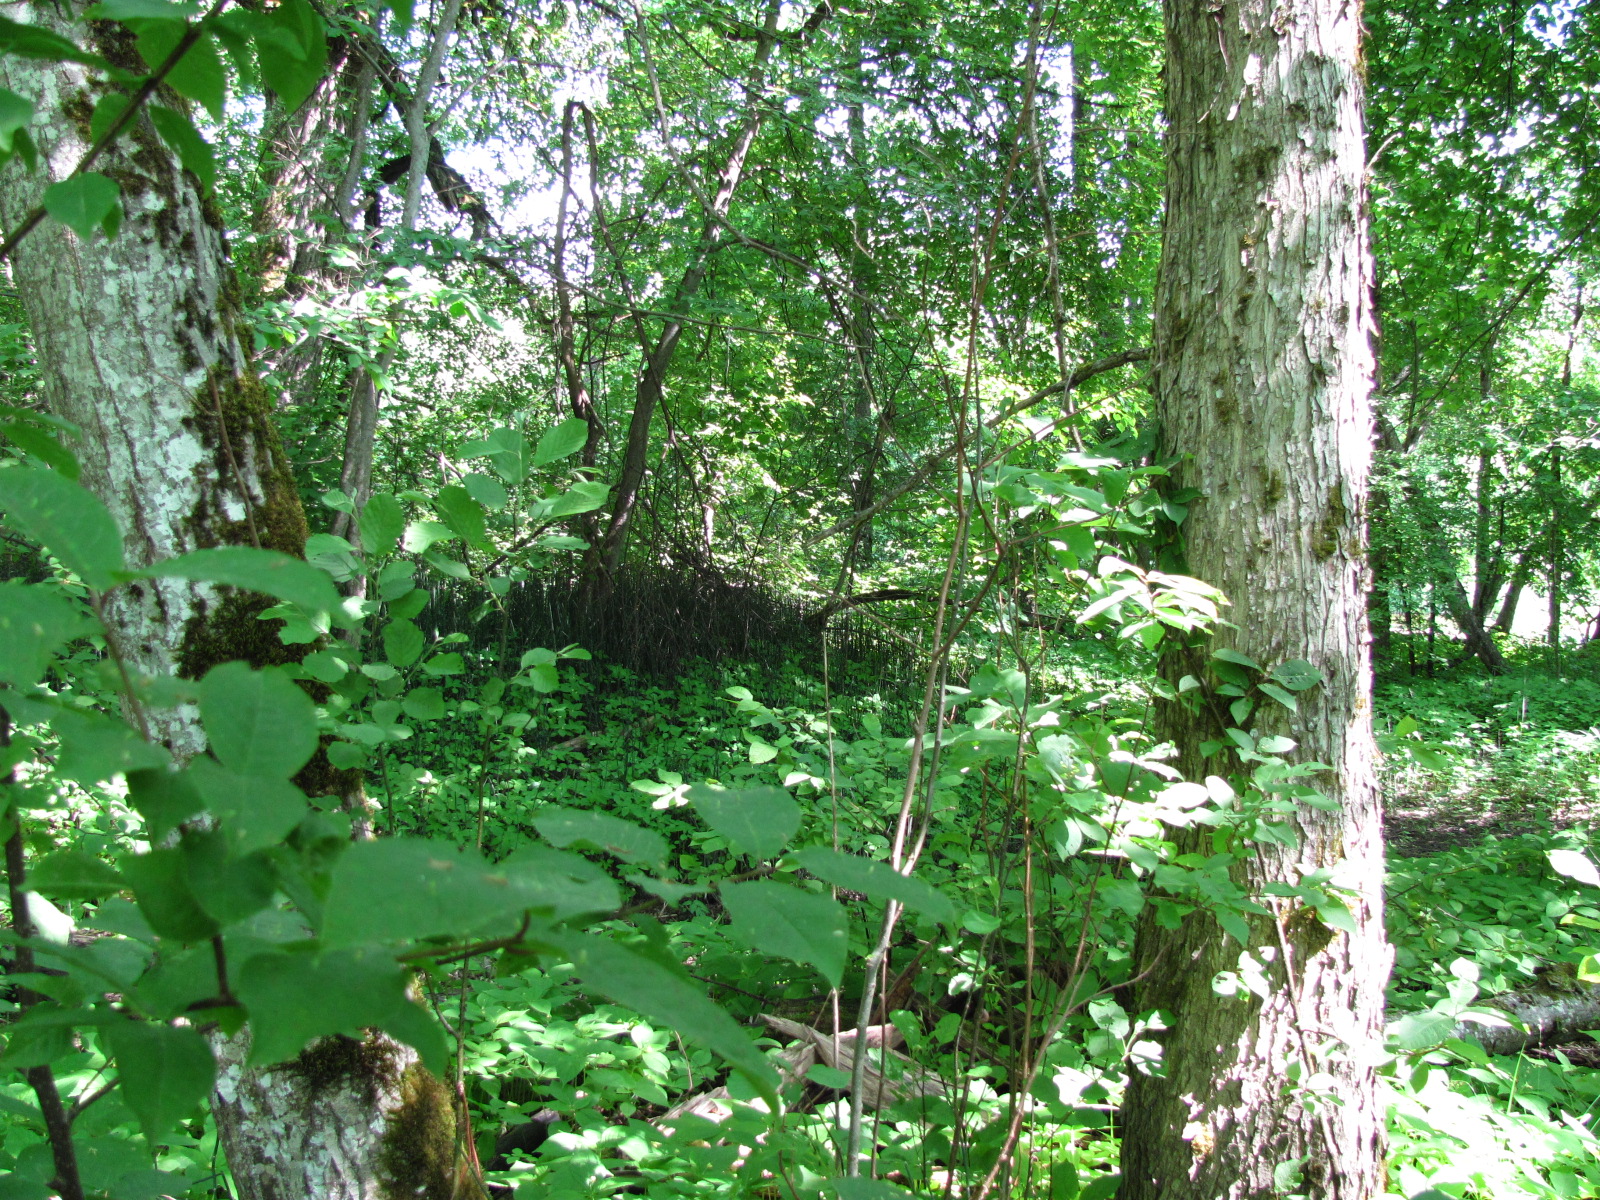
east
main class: Woodland
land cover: Broadleaved woodland
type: floodplain forest
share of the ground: > 75 %
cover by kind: broadleaved forest trees 100 %
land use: Semi-natural and natural areas not in use
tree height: > 5 m
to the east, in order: Broadleaved woodland; Grassland without tree/shrub cover; Inland fresh running water; Broadleaved woodland
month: June
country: LV
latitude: 56.9669
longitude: 24.5192
